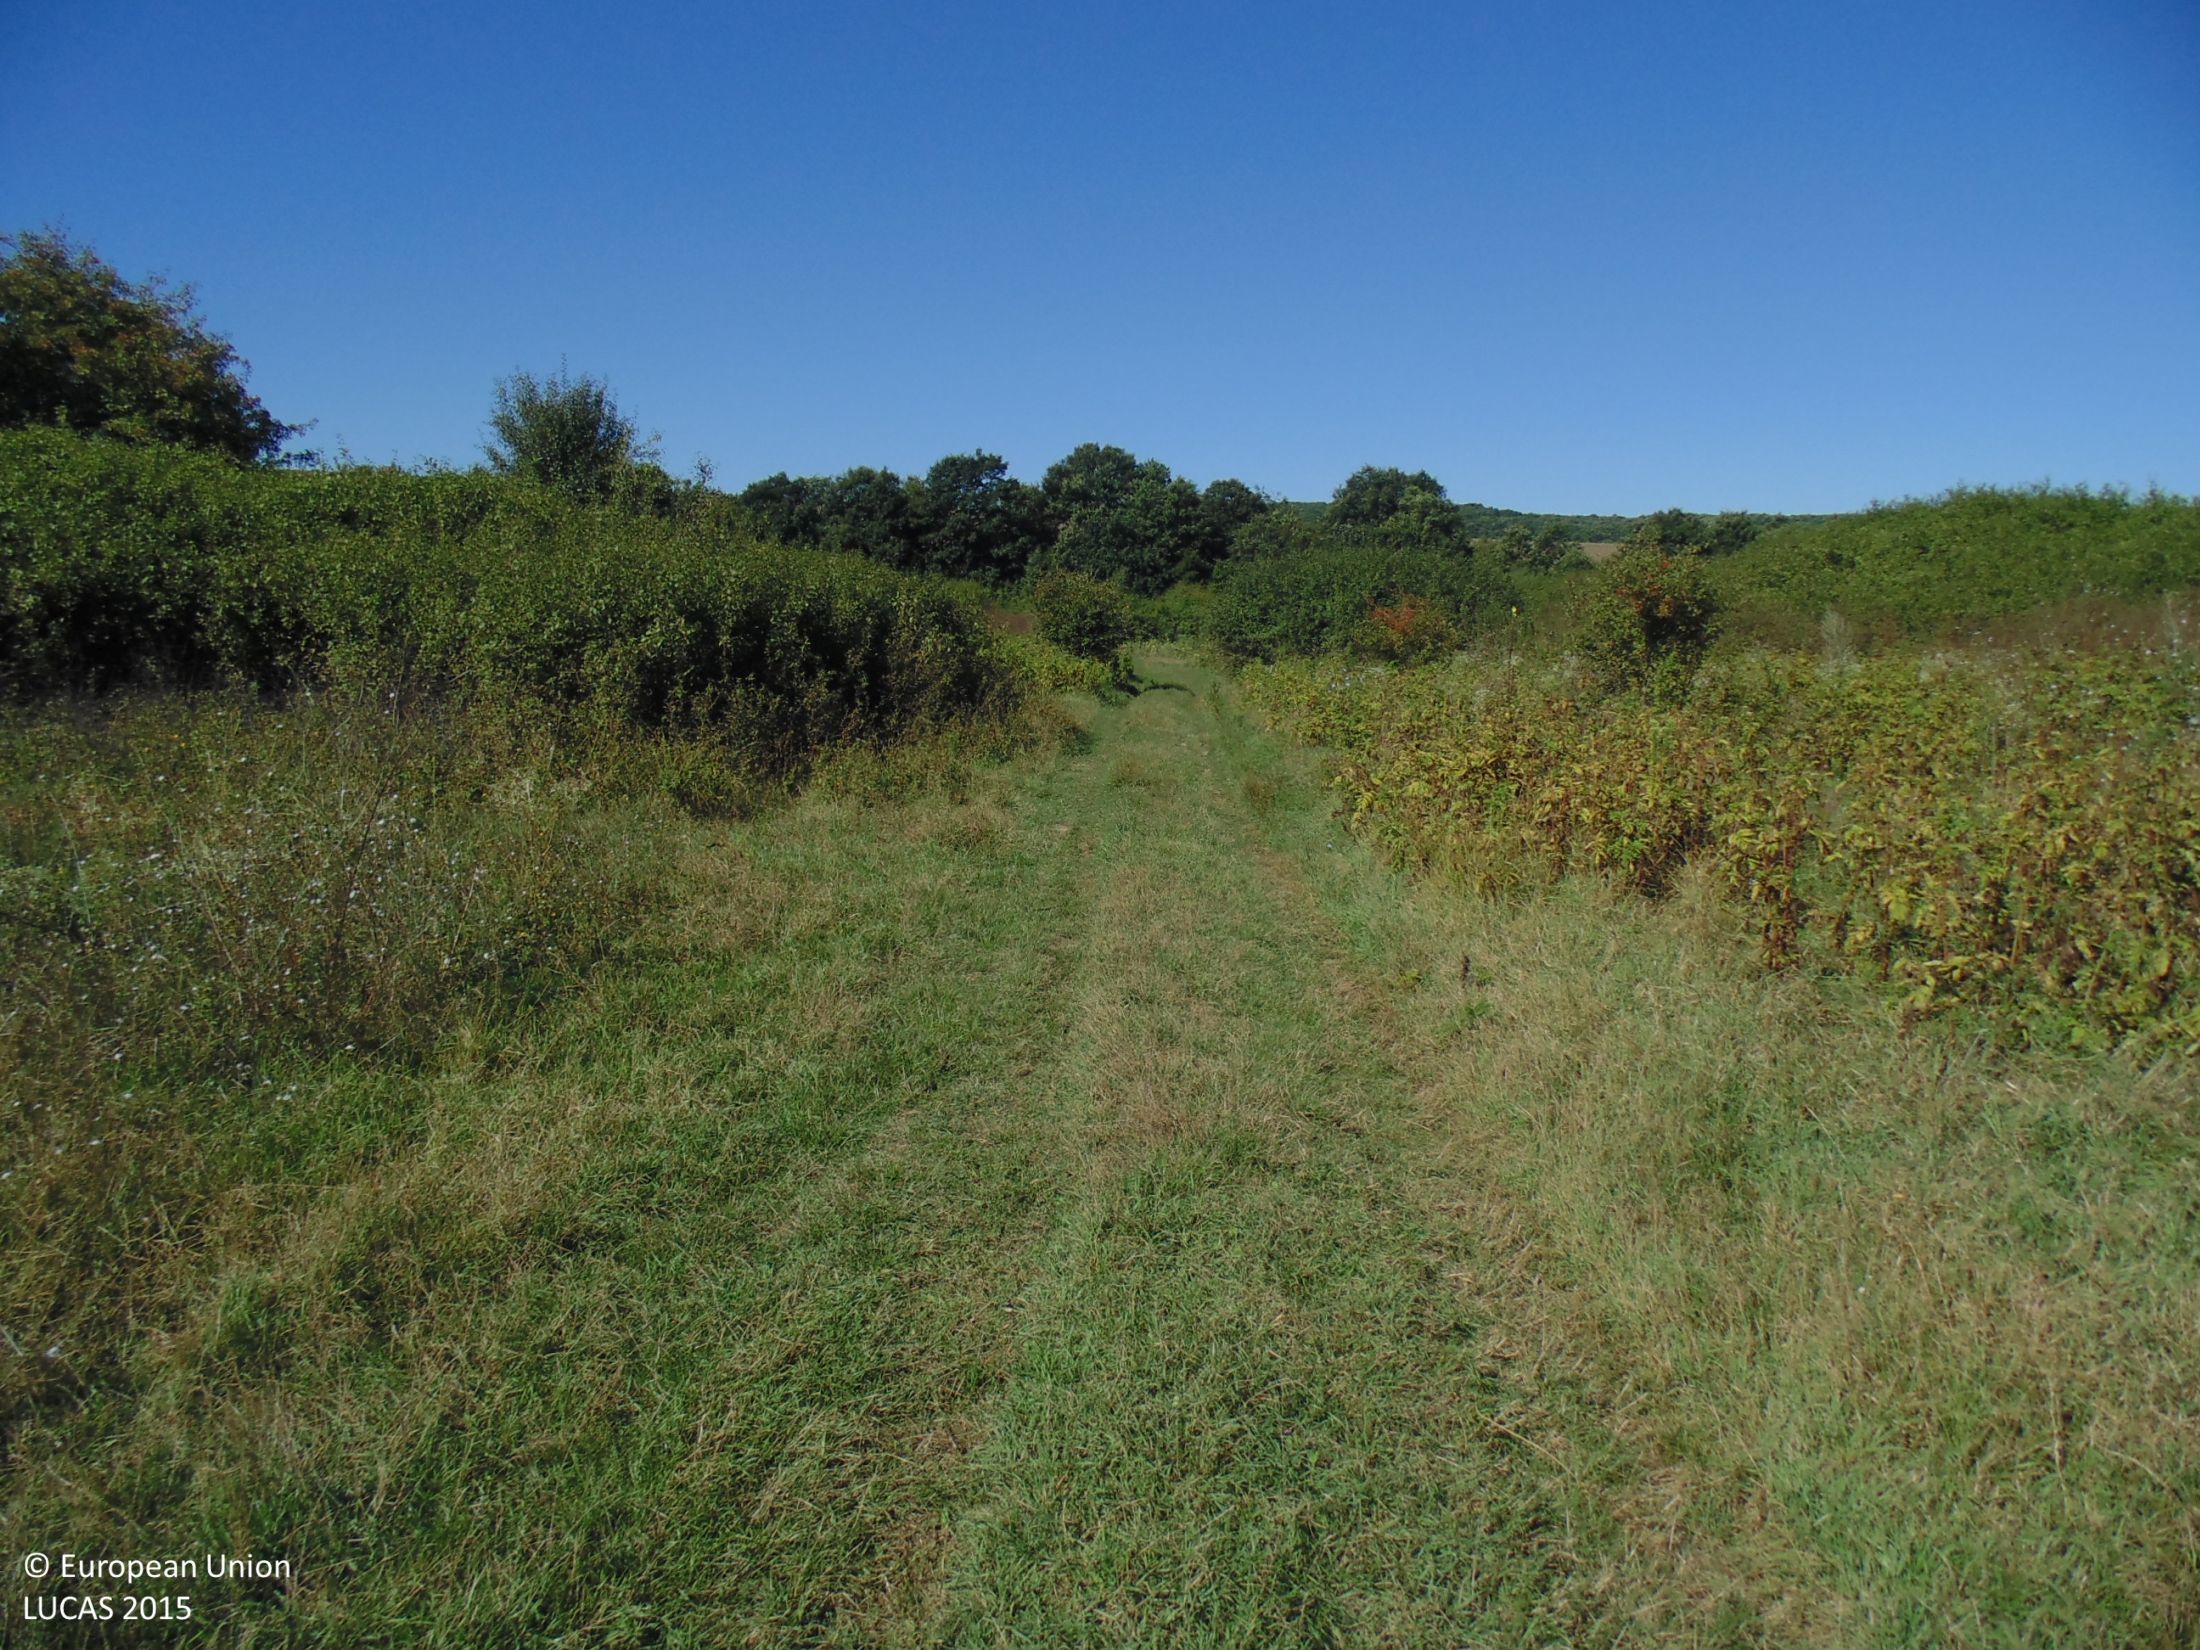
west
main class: Grassland
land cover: Grassland with sparse tree/shrub cover
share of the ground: > 75 %
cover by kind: herbaceous plants 90 %, broadleaved forest trees 5 %, shrubs 5 %
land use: Agriculture (excluding fallow land and kitchen gardens)
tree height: < 5 m
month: September
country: BG
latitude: 43.8013
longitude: 27.3196
